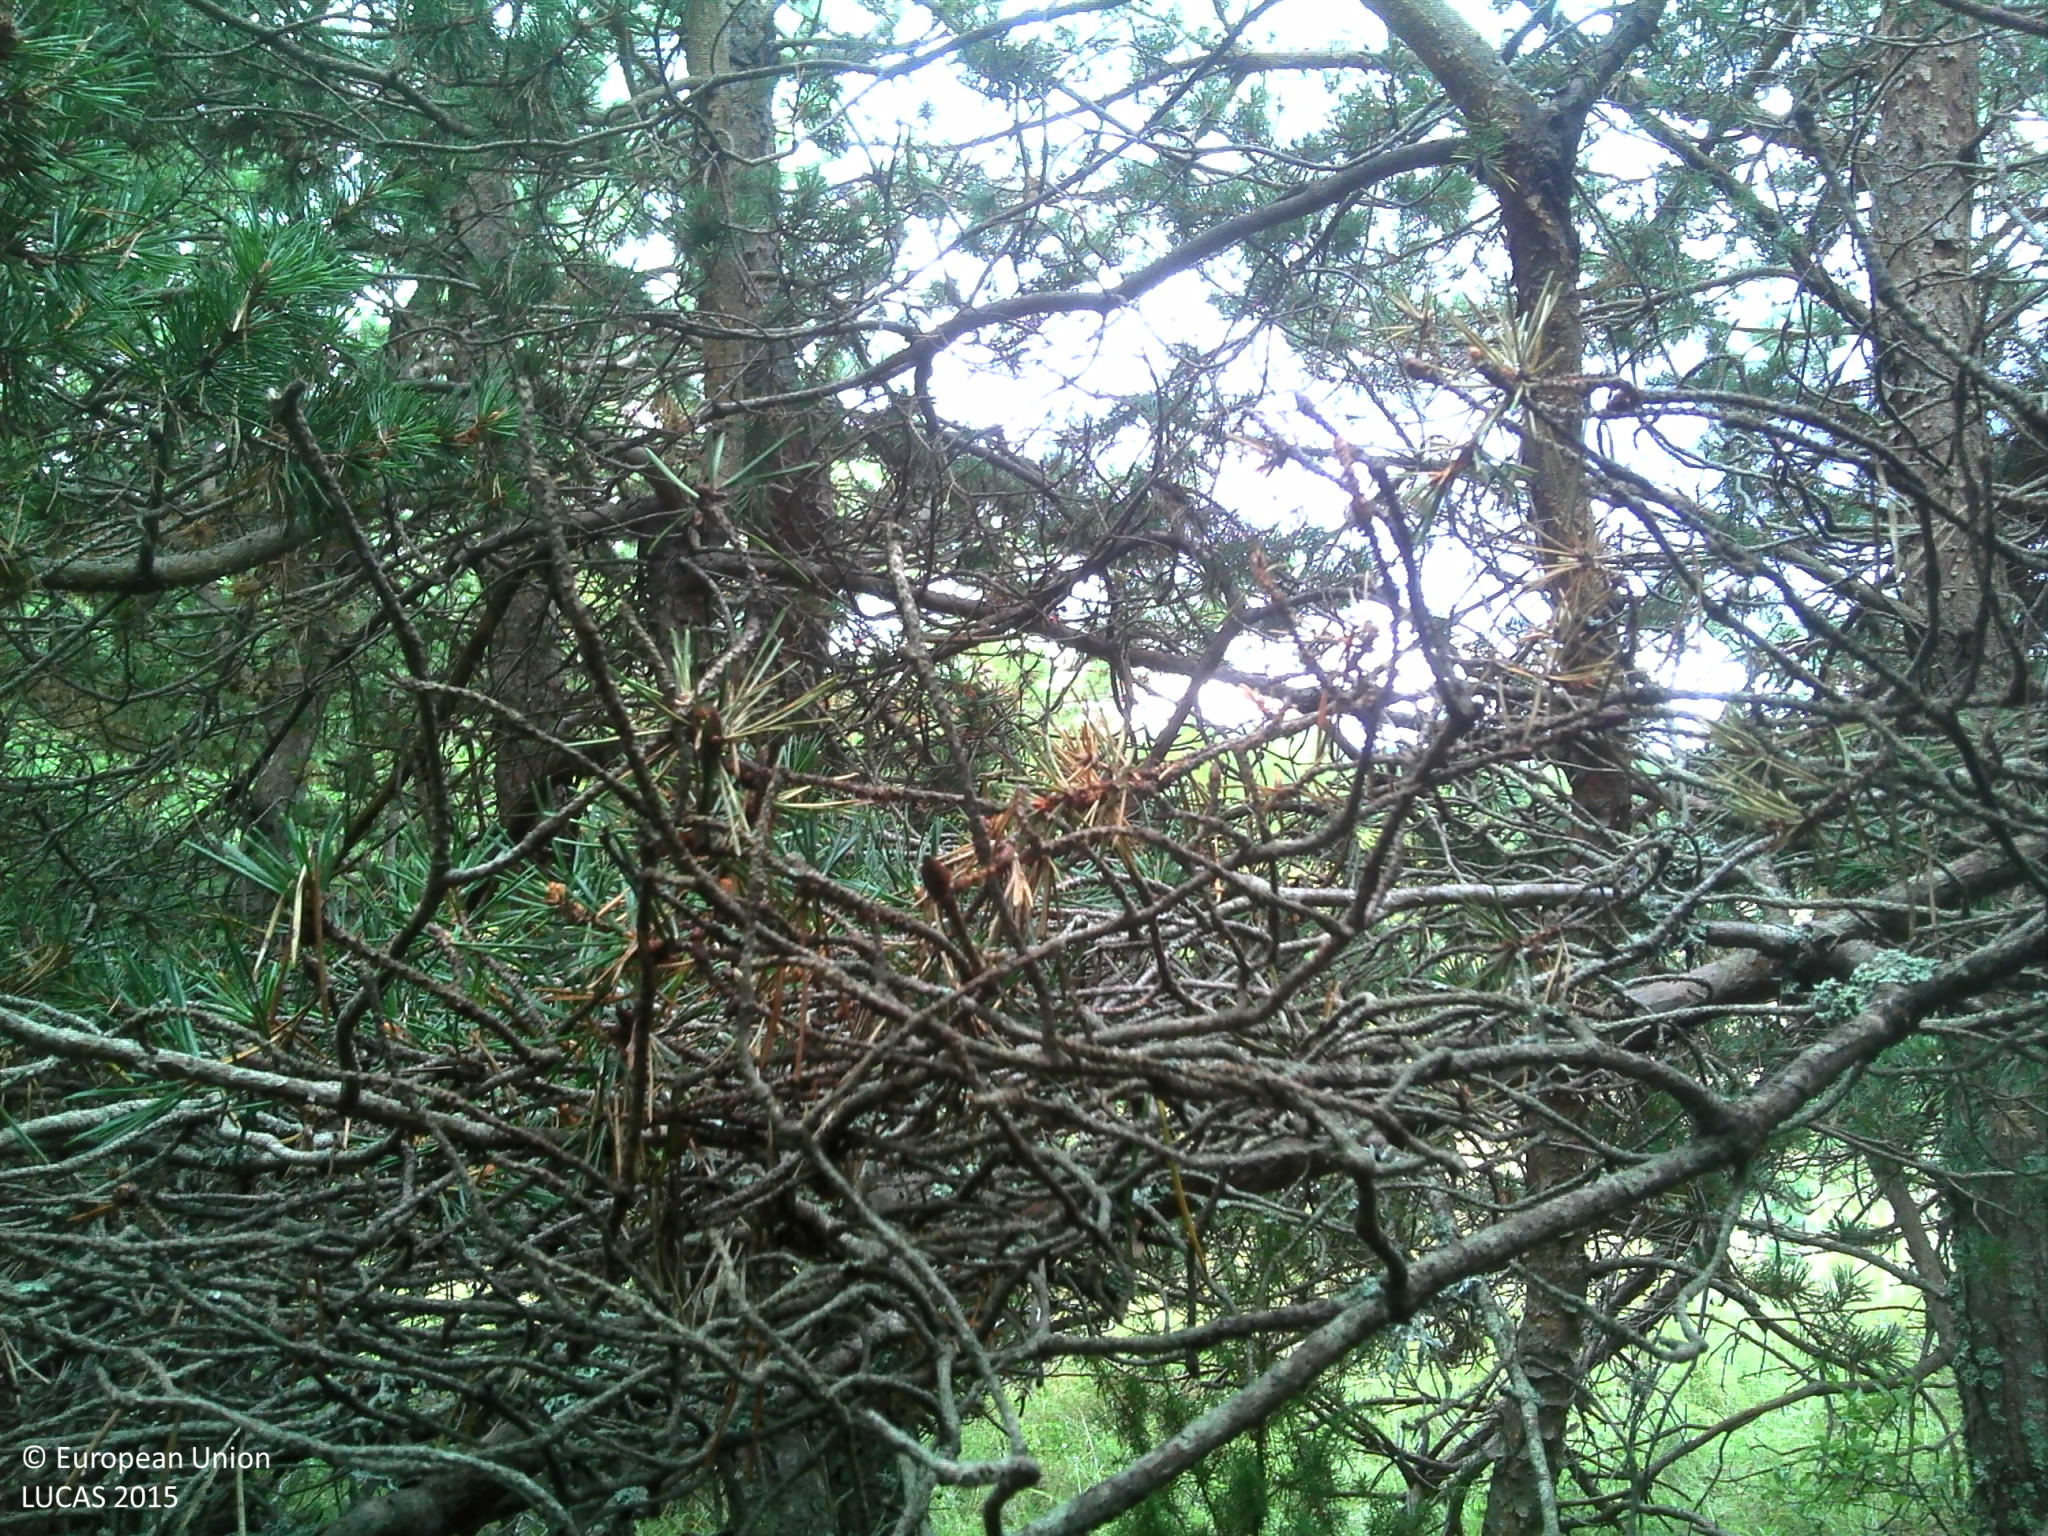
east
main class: Woodland
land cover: Pine dominated coniferous woodland
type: alpine coniferous forest
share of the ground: > 75 %
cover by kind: coniferous forest trees 90 %, broadleaved forest trees 5 %, herbaceous plants 5 %
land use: Forestry
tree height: > 5 m
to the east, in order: Pine dominated coniferous woodland; Grassland with sparse tree/shrub cover; Pine dominated coniferous woodland; Fences; Tracks; Fences; Broadleaved woodland; Grassland with sparse tree/shrub cover; Fences; Broadleaved woodland
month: September
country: FR
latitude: 44.5337
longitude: 5.3130
